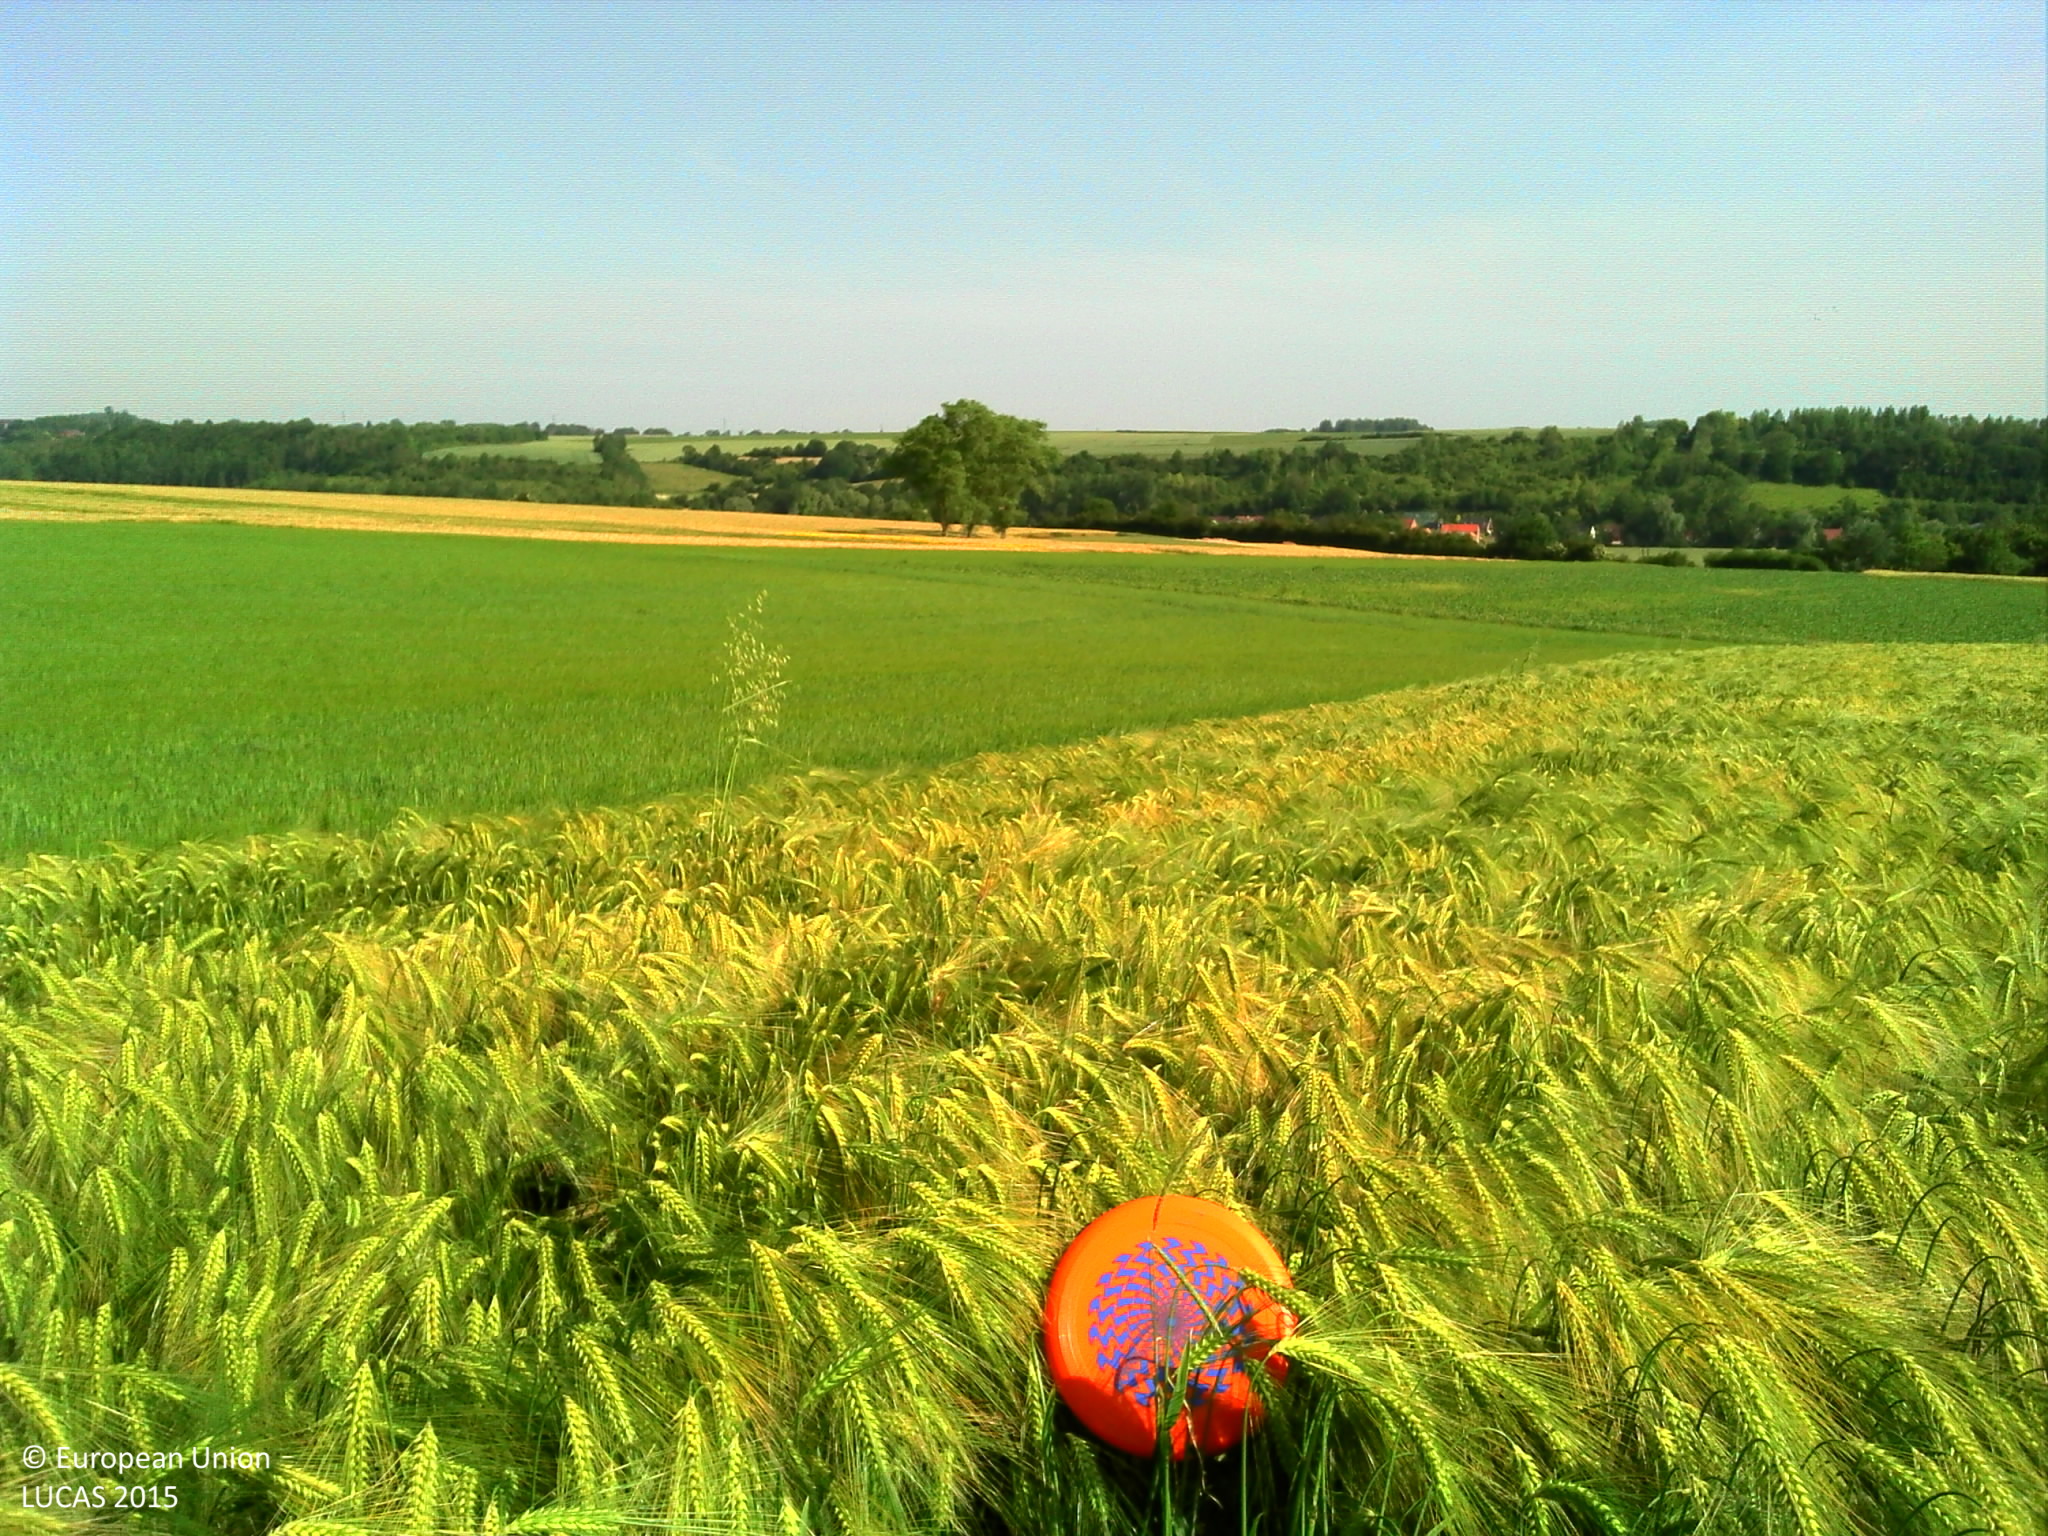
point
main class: Cropland
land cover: Barley
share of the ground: > 75 %
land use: Agriculture (excluding fallow land and kitchen gardens)
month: June
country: FR
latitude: 50.4755
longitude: 2.4484
